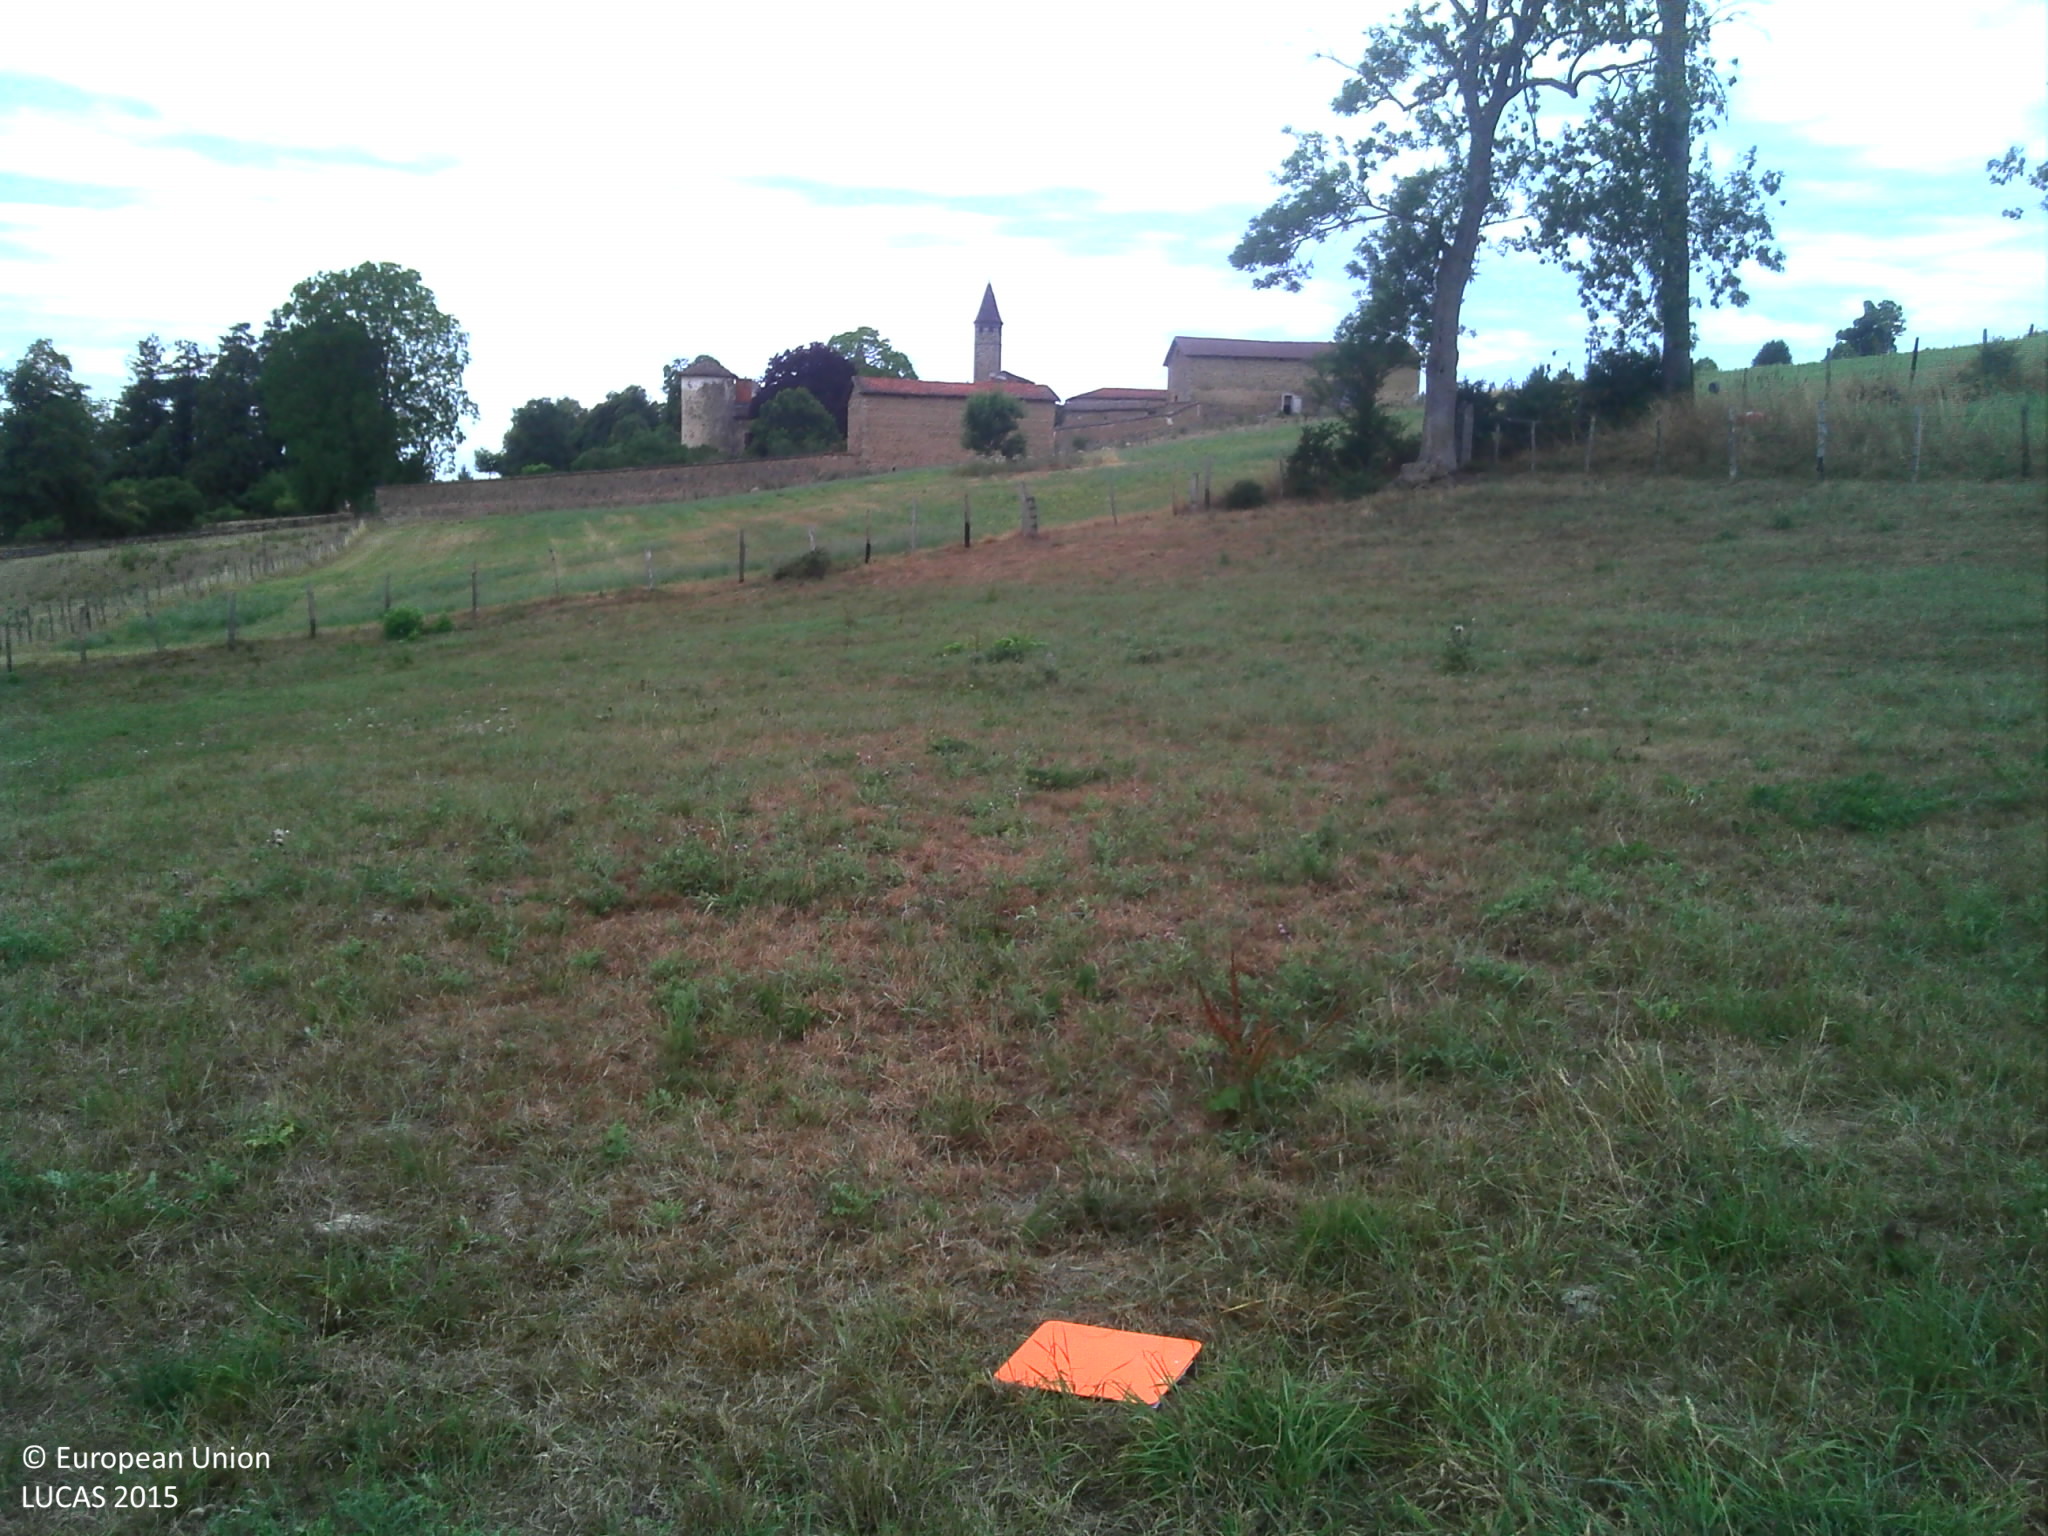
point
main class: Grassland
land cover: Grassland without tree/shrub cover
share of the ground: > 75 %
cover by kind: herbaceous plants 100 %
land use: Agriculture (excluding fallow land and kitchen gardens)
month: July
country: FR
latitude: 45.6486
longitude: 4.4730
